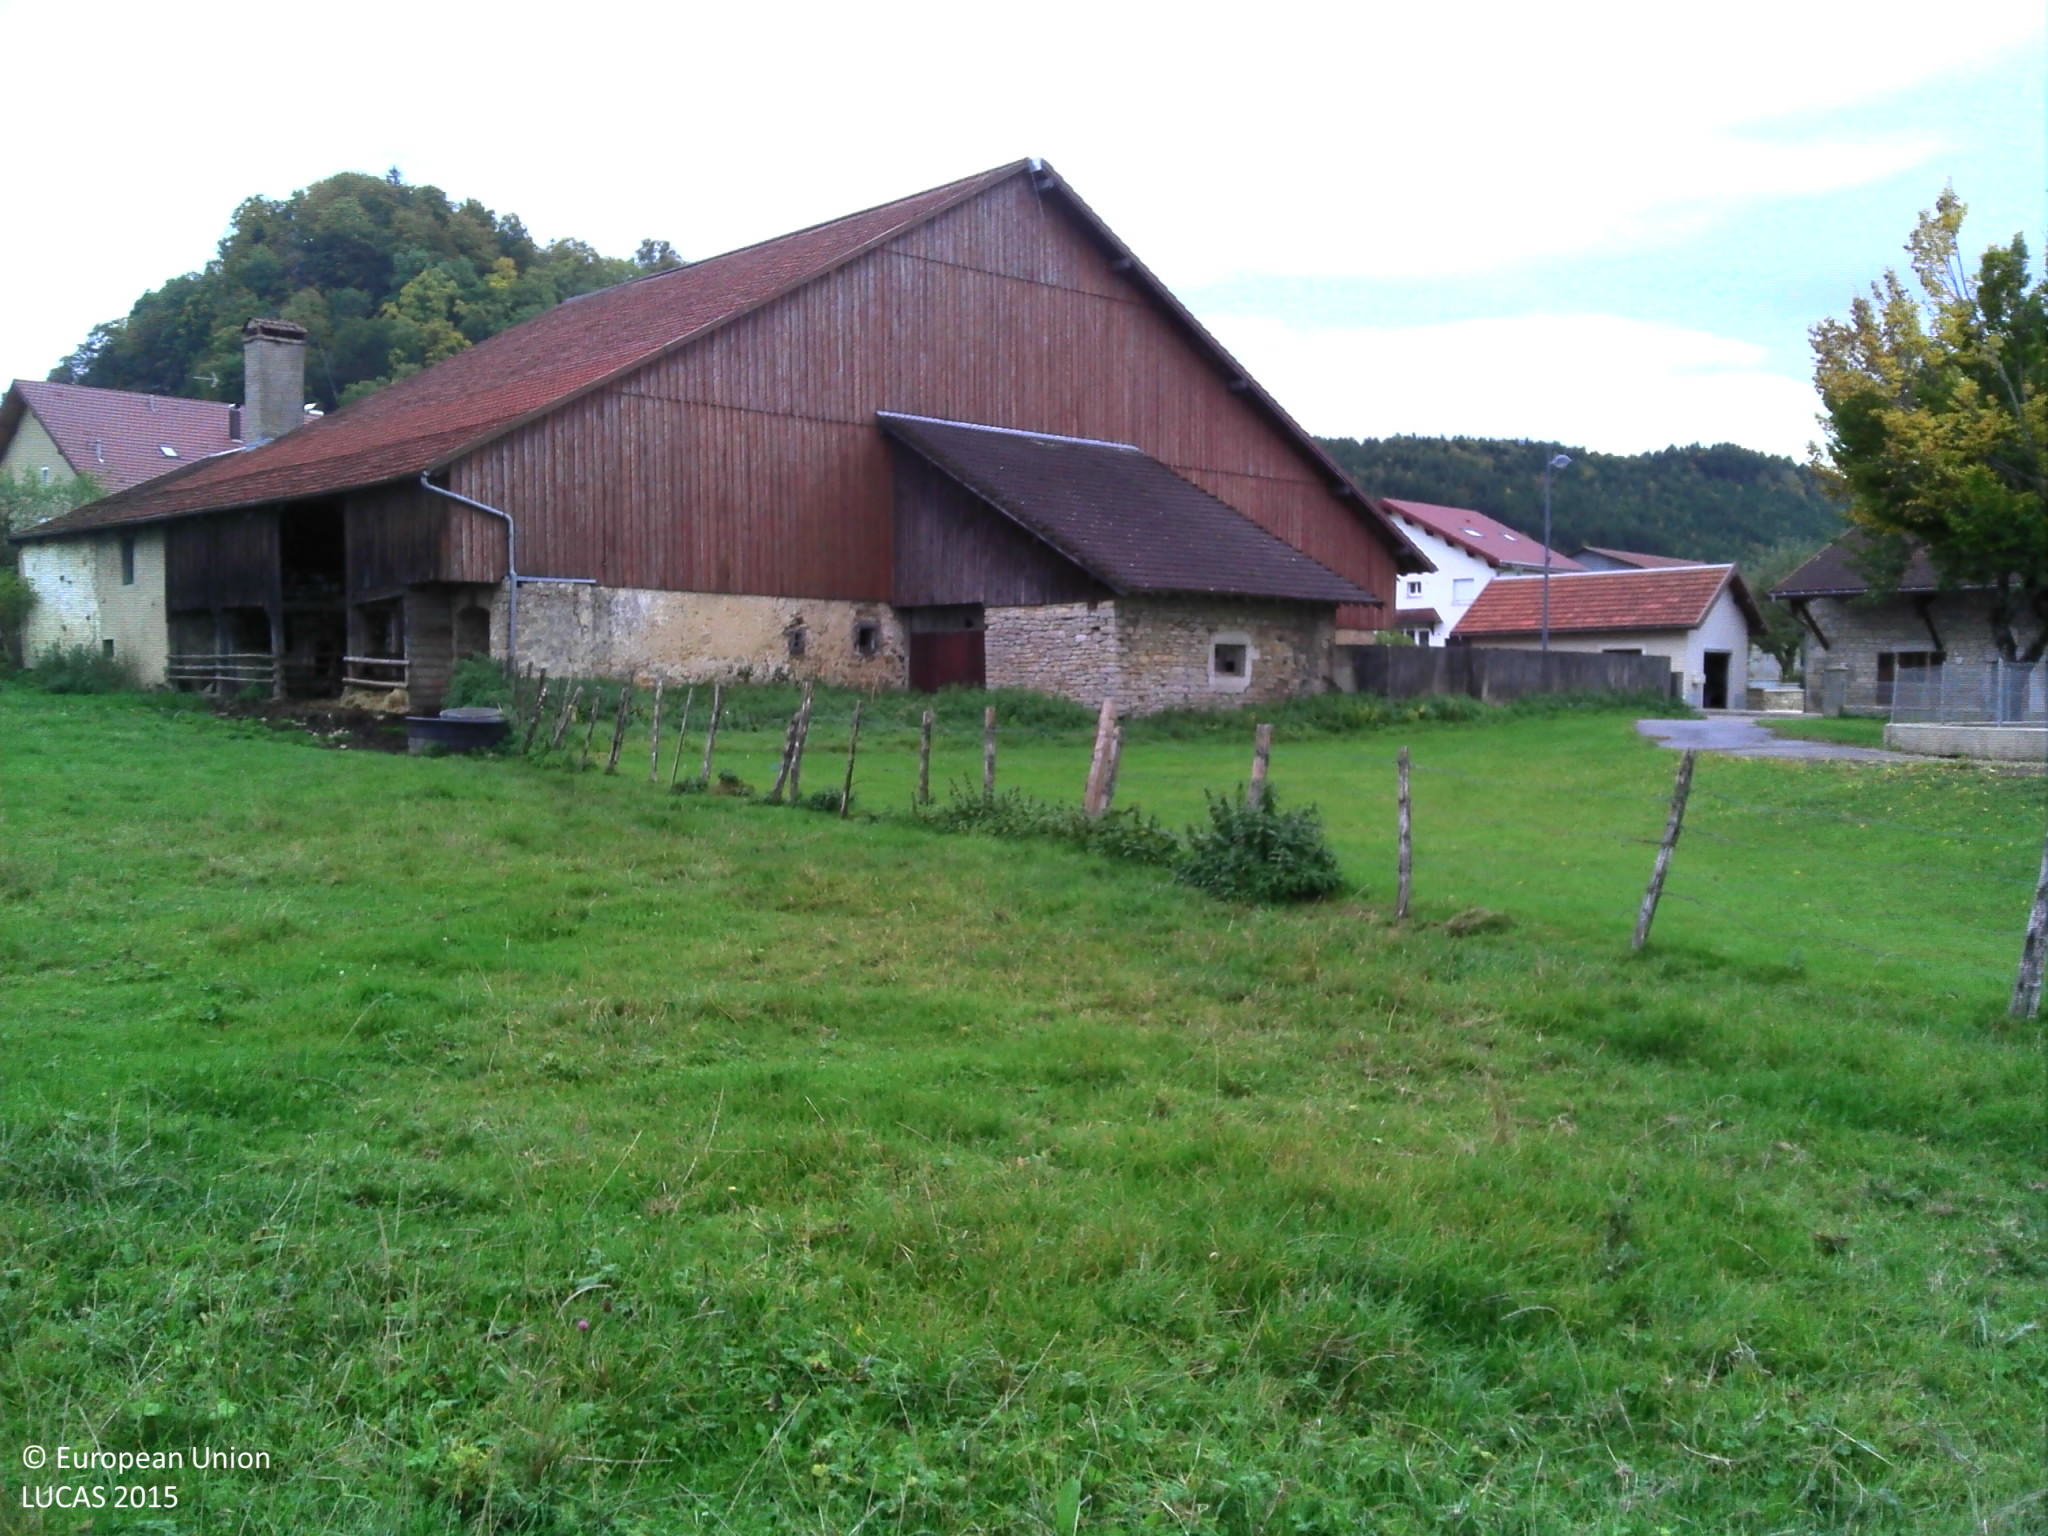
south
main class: Grassland
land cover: Grassland without tree/shrub cover
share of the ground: > 75 %
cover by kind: herbaceous plants 100 %
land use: Agriculture (excluding fallow land and kitchen gardens)
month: October
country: FR
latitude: 46.9528
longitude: 6.2575
